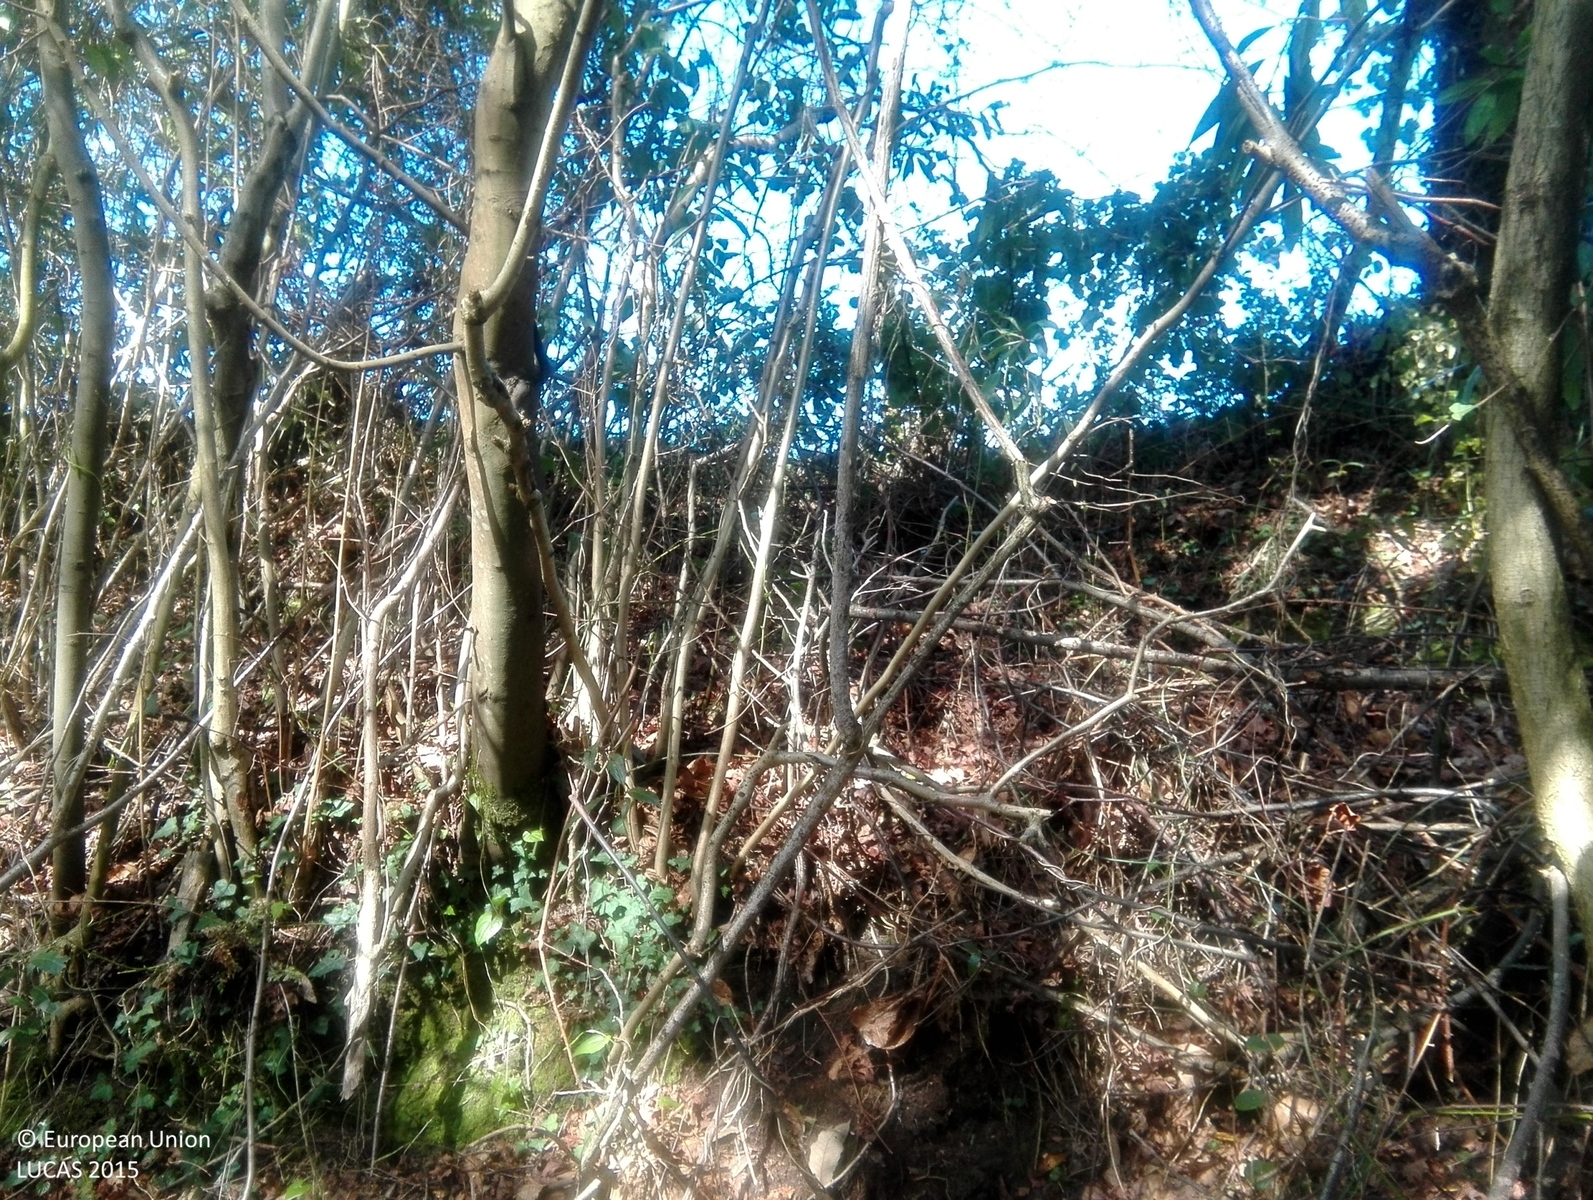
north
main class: Woodland
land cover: Broadleaved woodland
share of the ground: > 75 %
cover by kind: broadleaved forest trees 100 %
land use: Semi-natural and natural areas not in use
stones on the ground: < 10 %
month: April
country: ES
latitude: 43.4139
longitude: -5.6320
